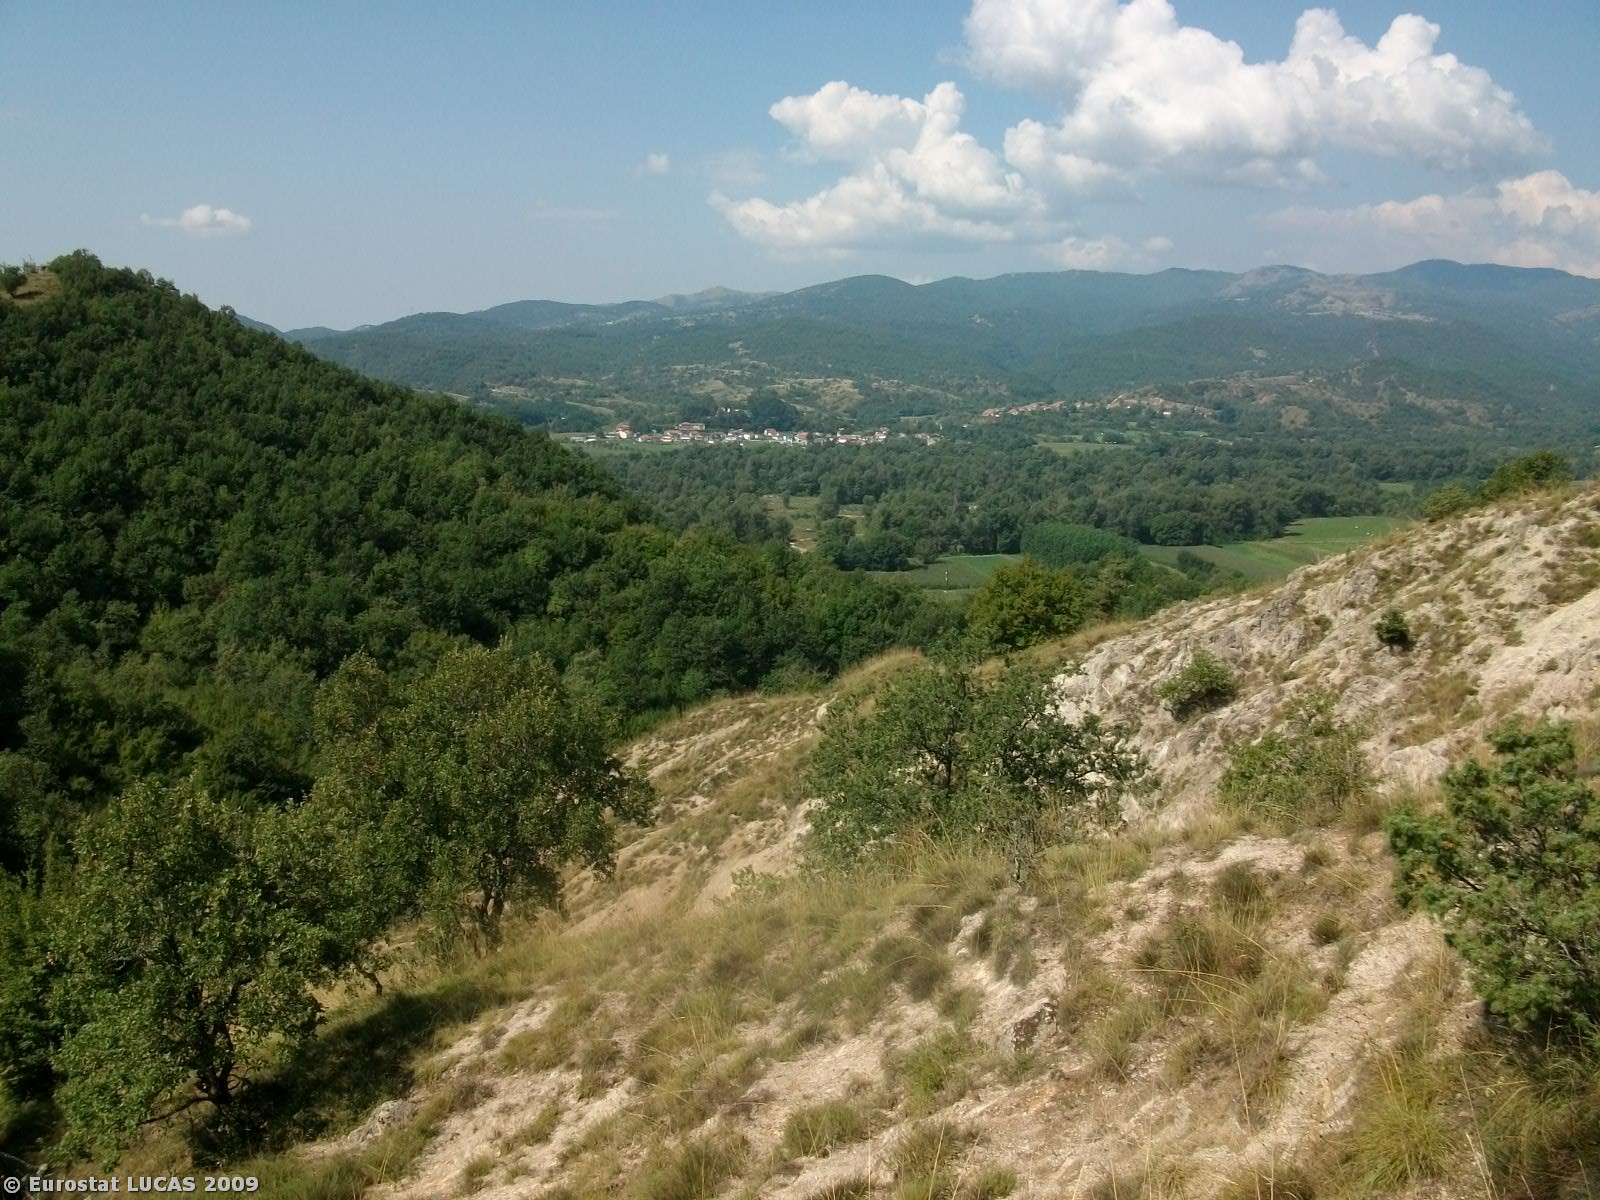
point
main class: Shrubland
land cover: Shrubland with sparse tree cover
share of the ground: > 75 %
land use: Unused
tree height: < 5 m
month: August
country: GR
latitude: 41.2754
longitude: 24.4938
